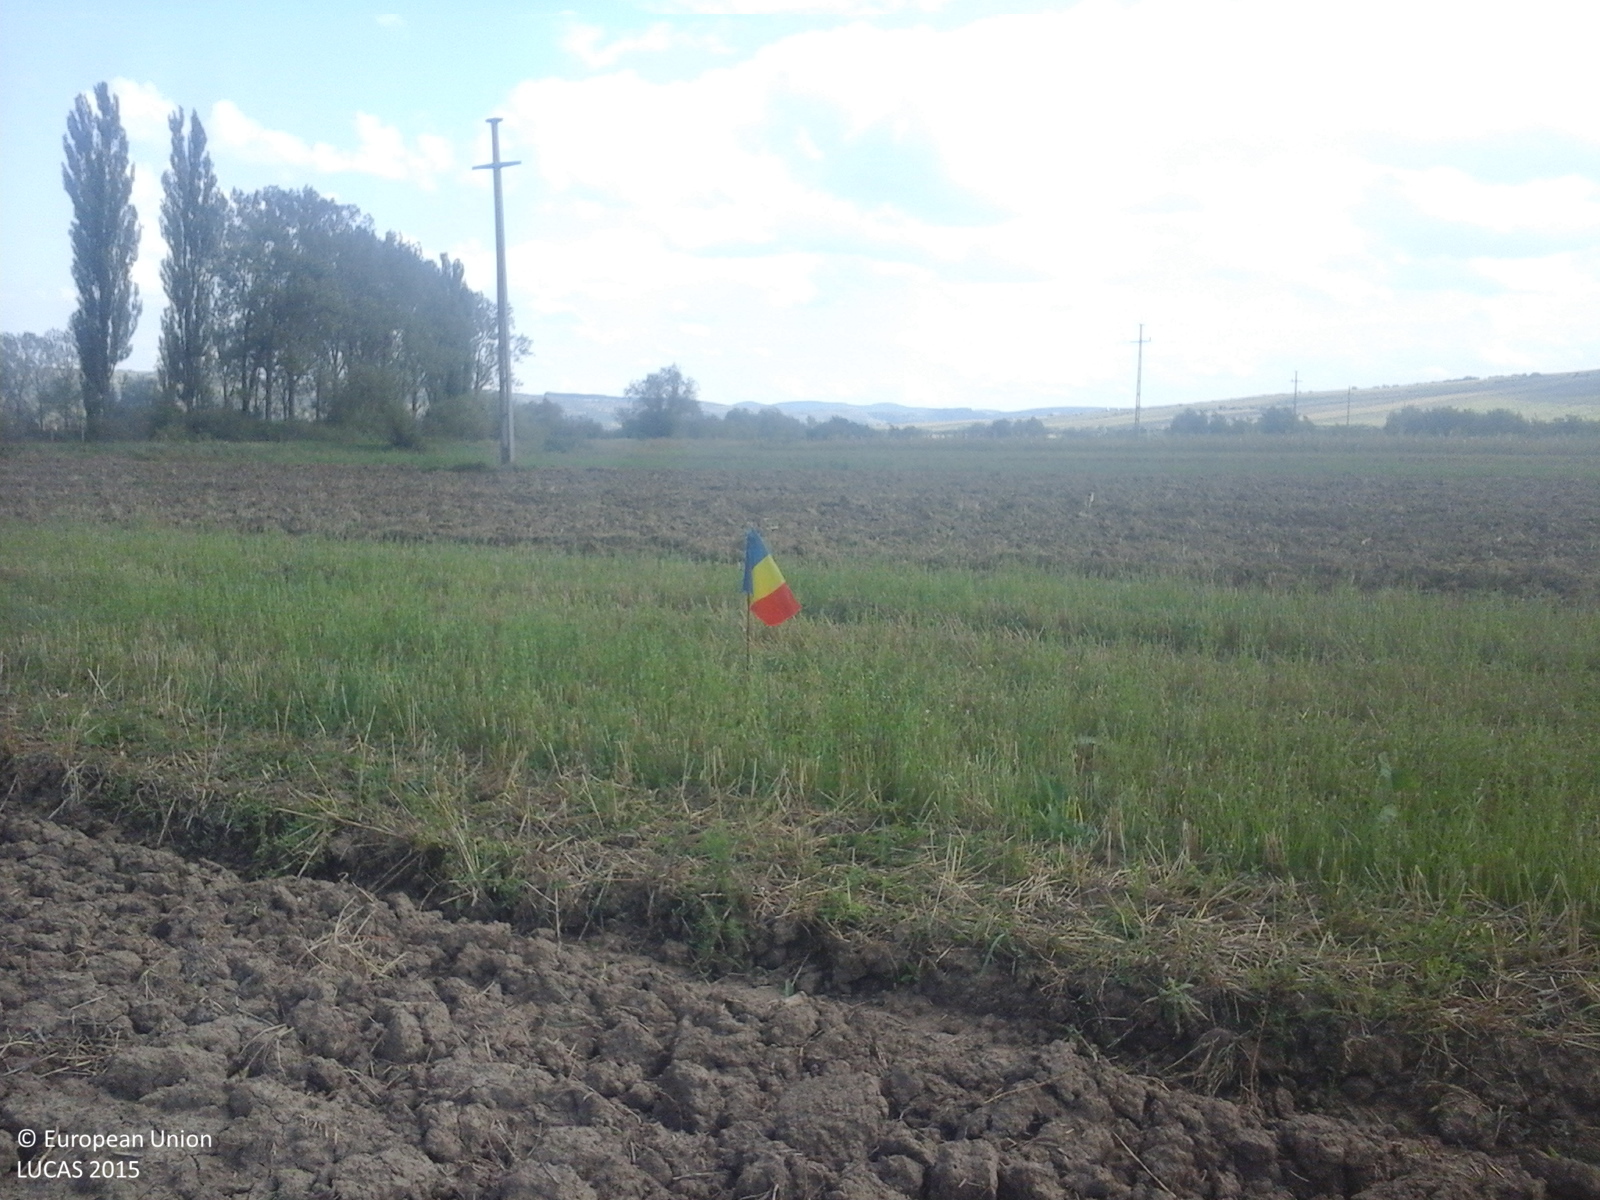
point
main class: Cropland
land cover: Common wheat
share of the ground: > 75 %
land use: Agriculture (excluding fallow land and kitchen gardens)
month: September
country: RO
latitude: 47.3275
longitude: 22.8033
